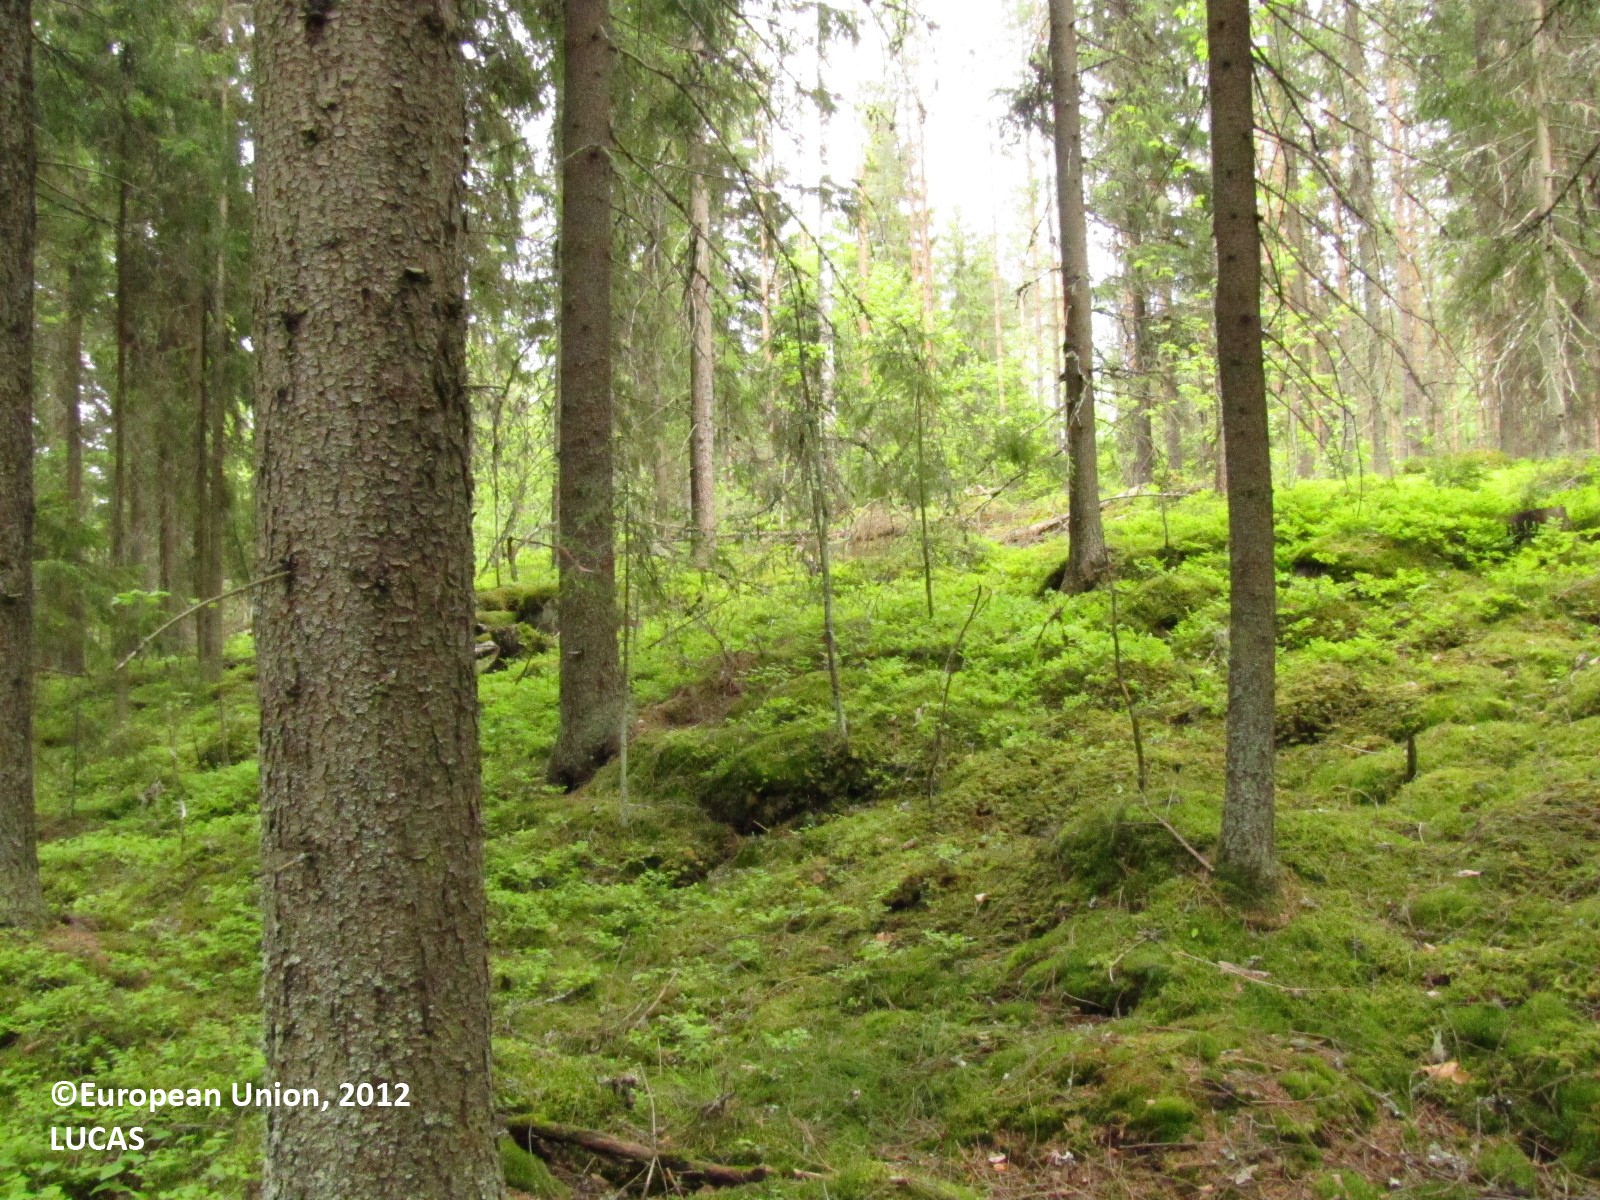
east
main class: Woodland
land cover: Spruce dominated coniferous woodland
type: hemiboreal forest and nemoral coniferous forest and mixed broadleaved-coniferous forest
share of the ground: > 75 %
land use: Forestry
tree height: > 5 m
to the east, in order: Spruce dominated coniferous woodland; Electric lines; Ditches and canals; Grass margins; Tracks
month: June
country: FI
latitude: 61.6155
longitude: 23.1017
